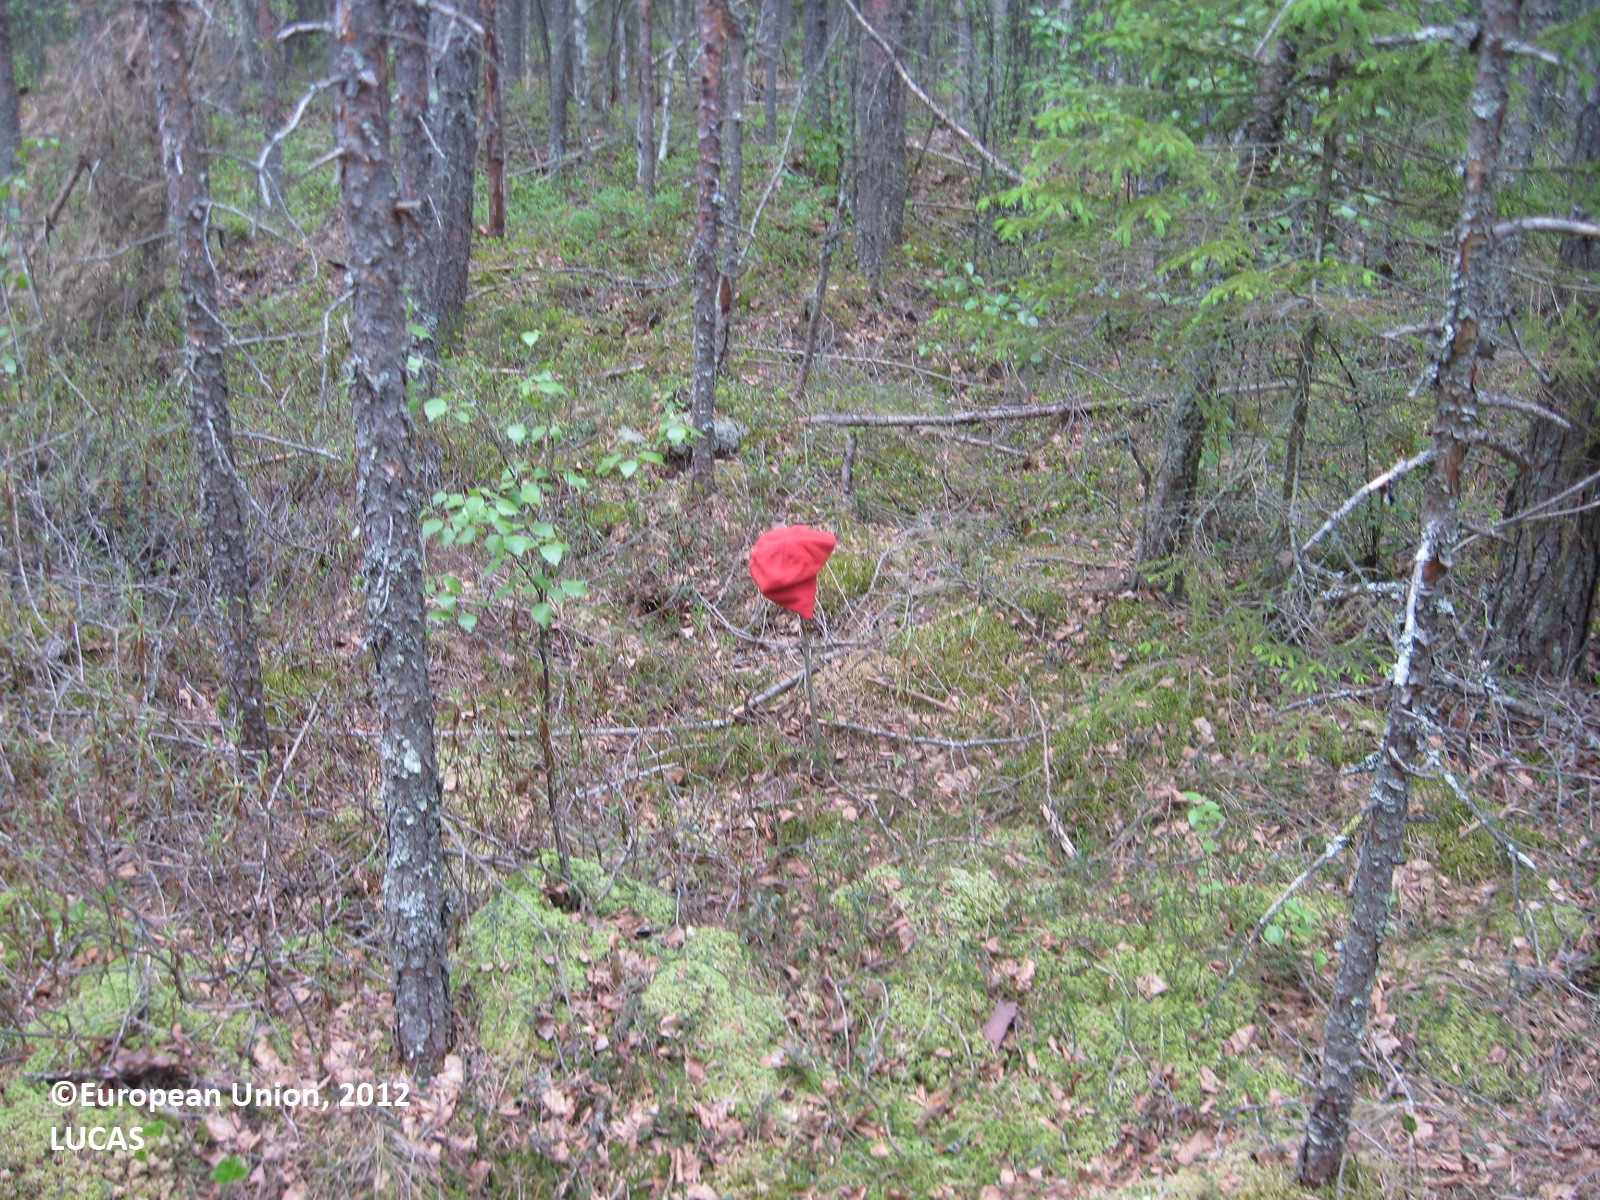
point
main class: Woodland
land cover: Pine dominated mixed woodland
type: boreal forest
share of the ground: > 75 %
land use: Forestry
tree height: > 5 m
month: June
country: FI
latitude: 63.1672
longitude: 22.7423
